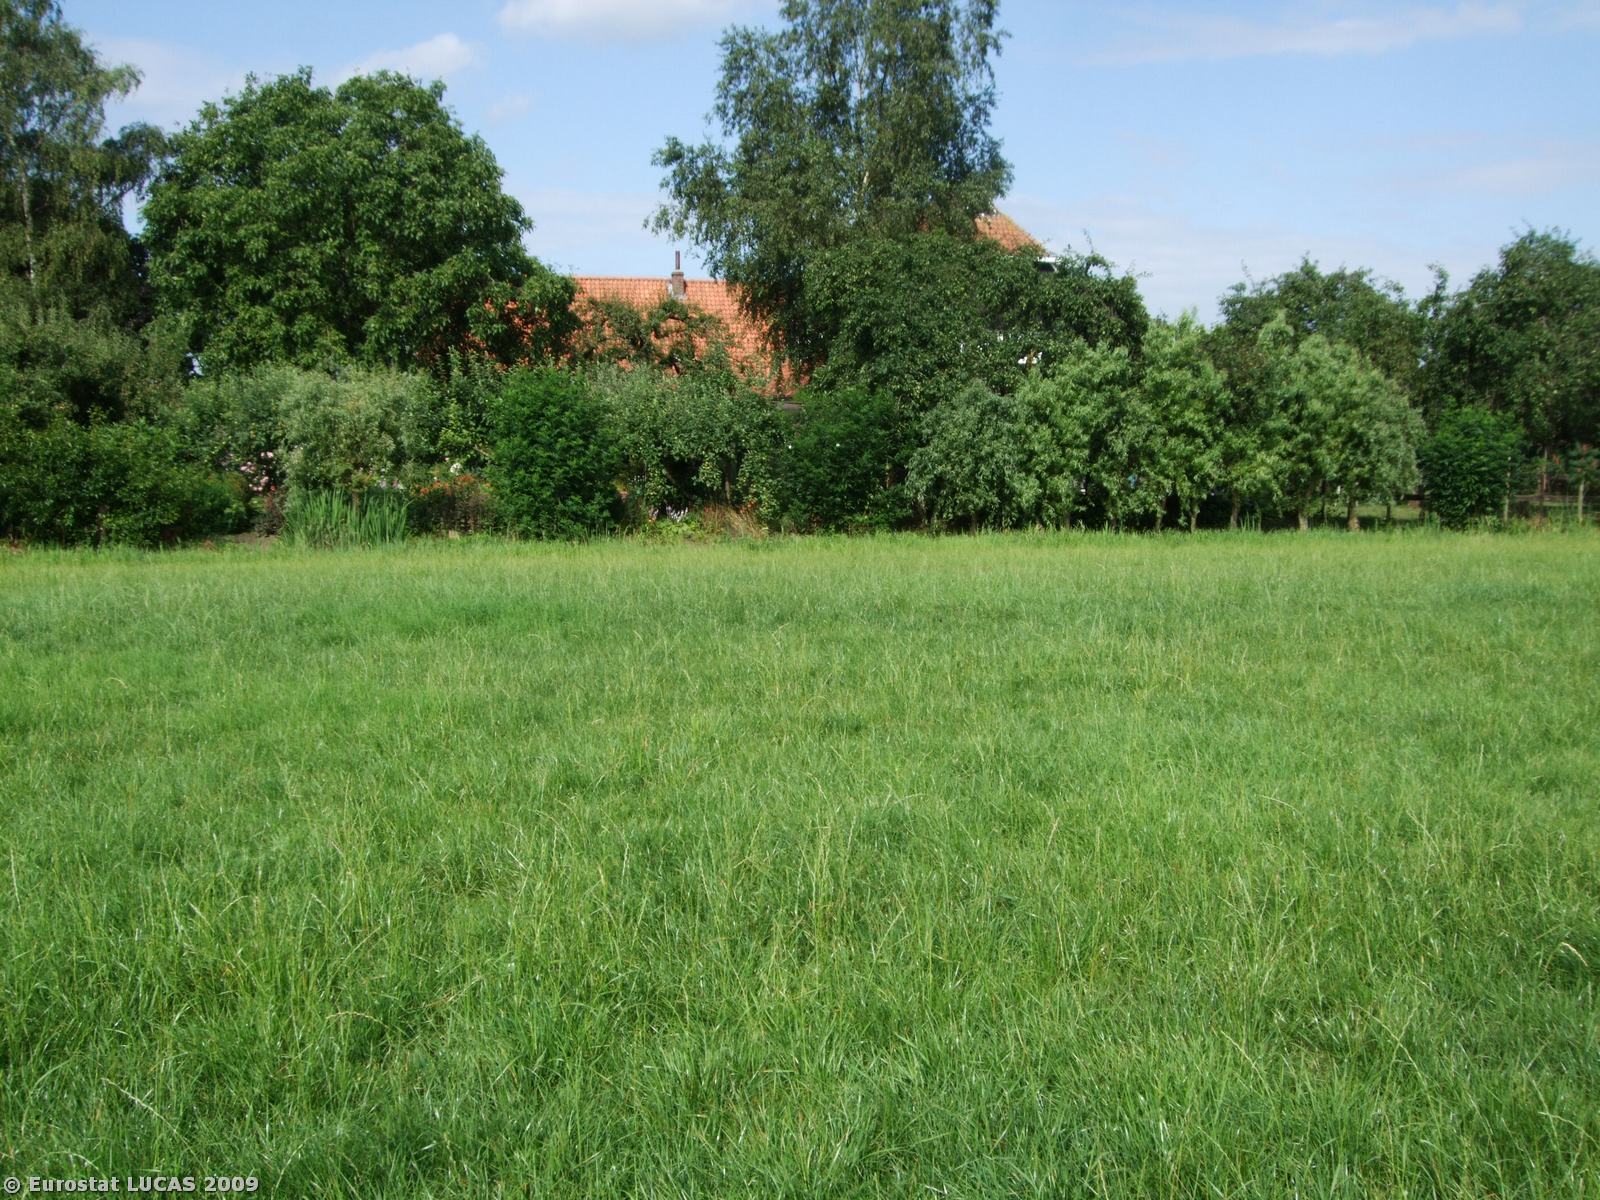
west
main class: Grassland
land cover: Grassland without tree/shrub cover
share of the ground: > 75 %
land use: Agriculture (excluding fallow land and kitchen gardens)
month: July
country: NL
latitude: 51.9458
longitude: 5.3863
